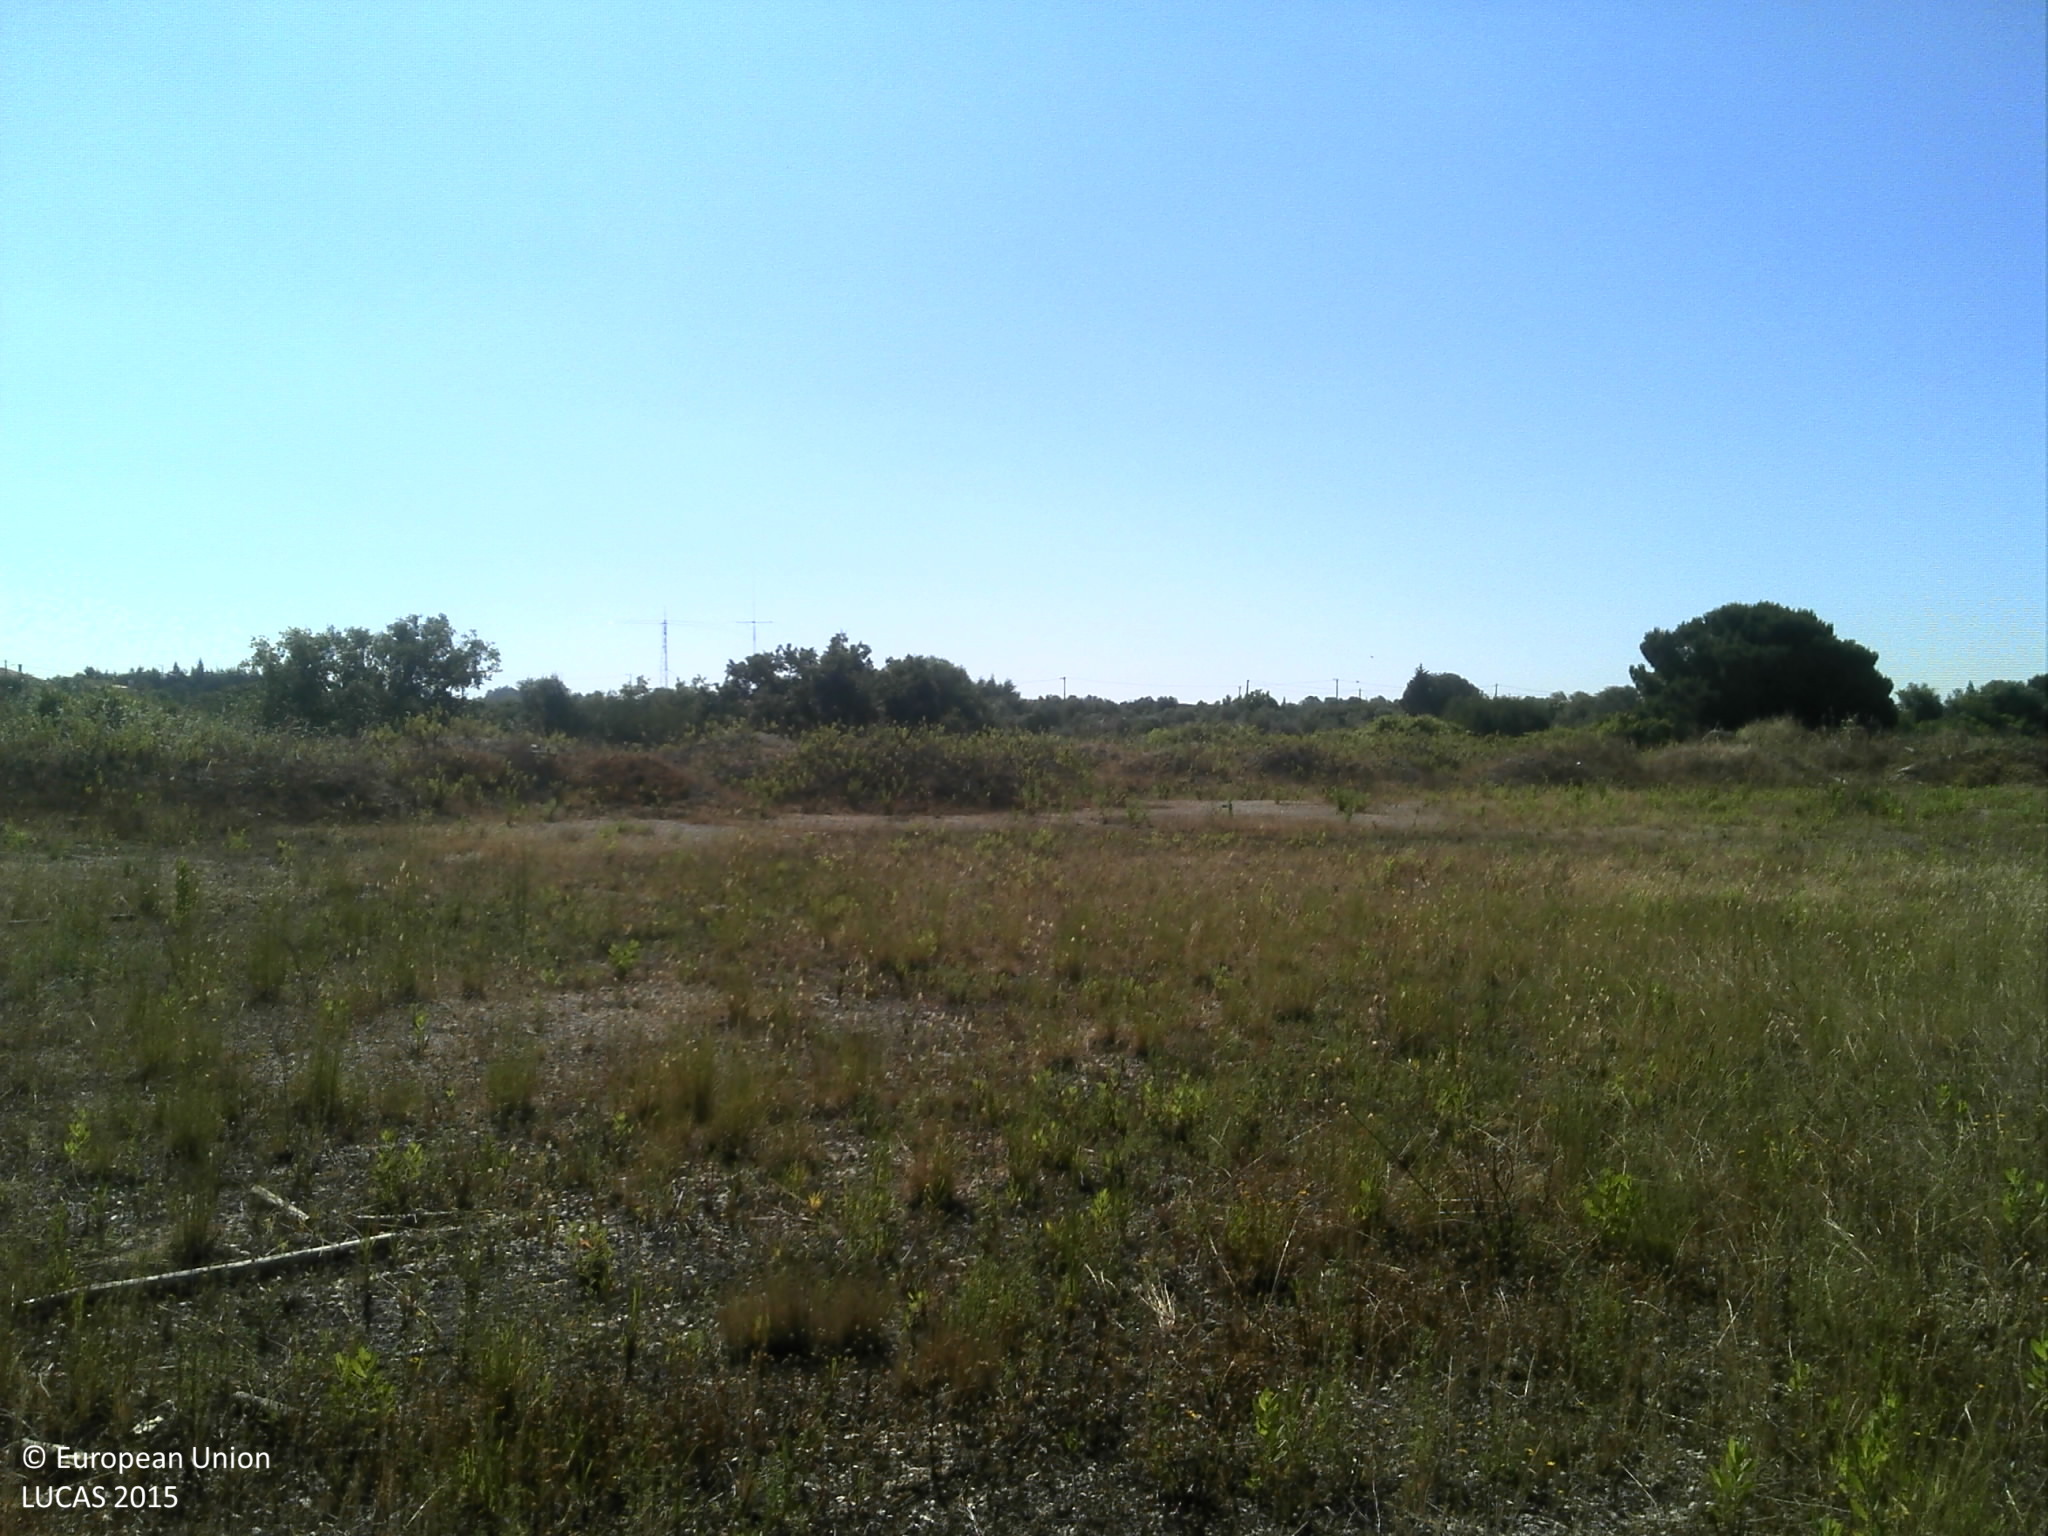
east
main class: Grassland
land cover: Spontaneously vegetated surfaces
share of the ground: 25 - 50 %
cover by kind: herbaceous plants 55 %, unconsolidated bare surface 40 %, shrubs 5 %
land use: Abandoned areas
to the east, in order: Spontaneously vegetated surfaces; Shrubland with sparse tree cover; Shrubland without tree cover; Shrubland with sparse tree cover
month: June
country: PT
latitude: 39.2351
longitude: -8.7615
